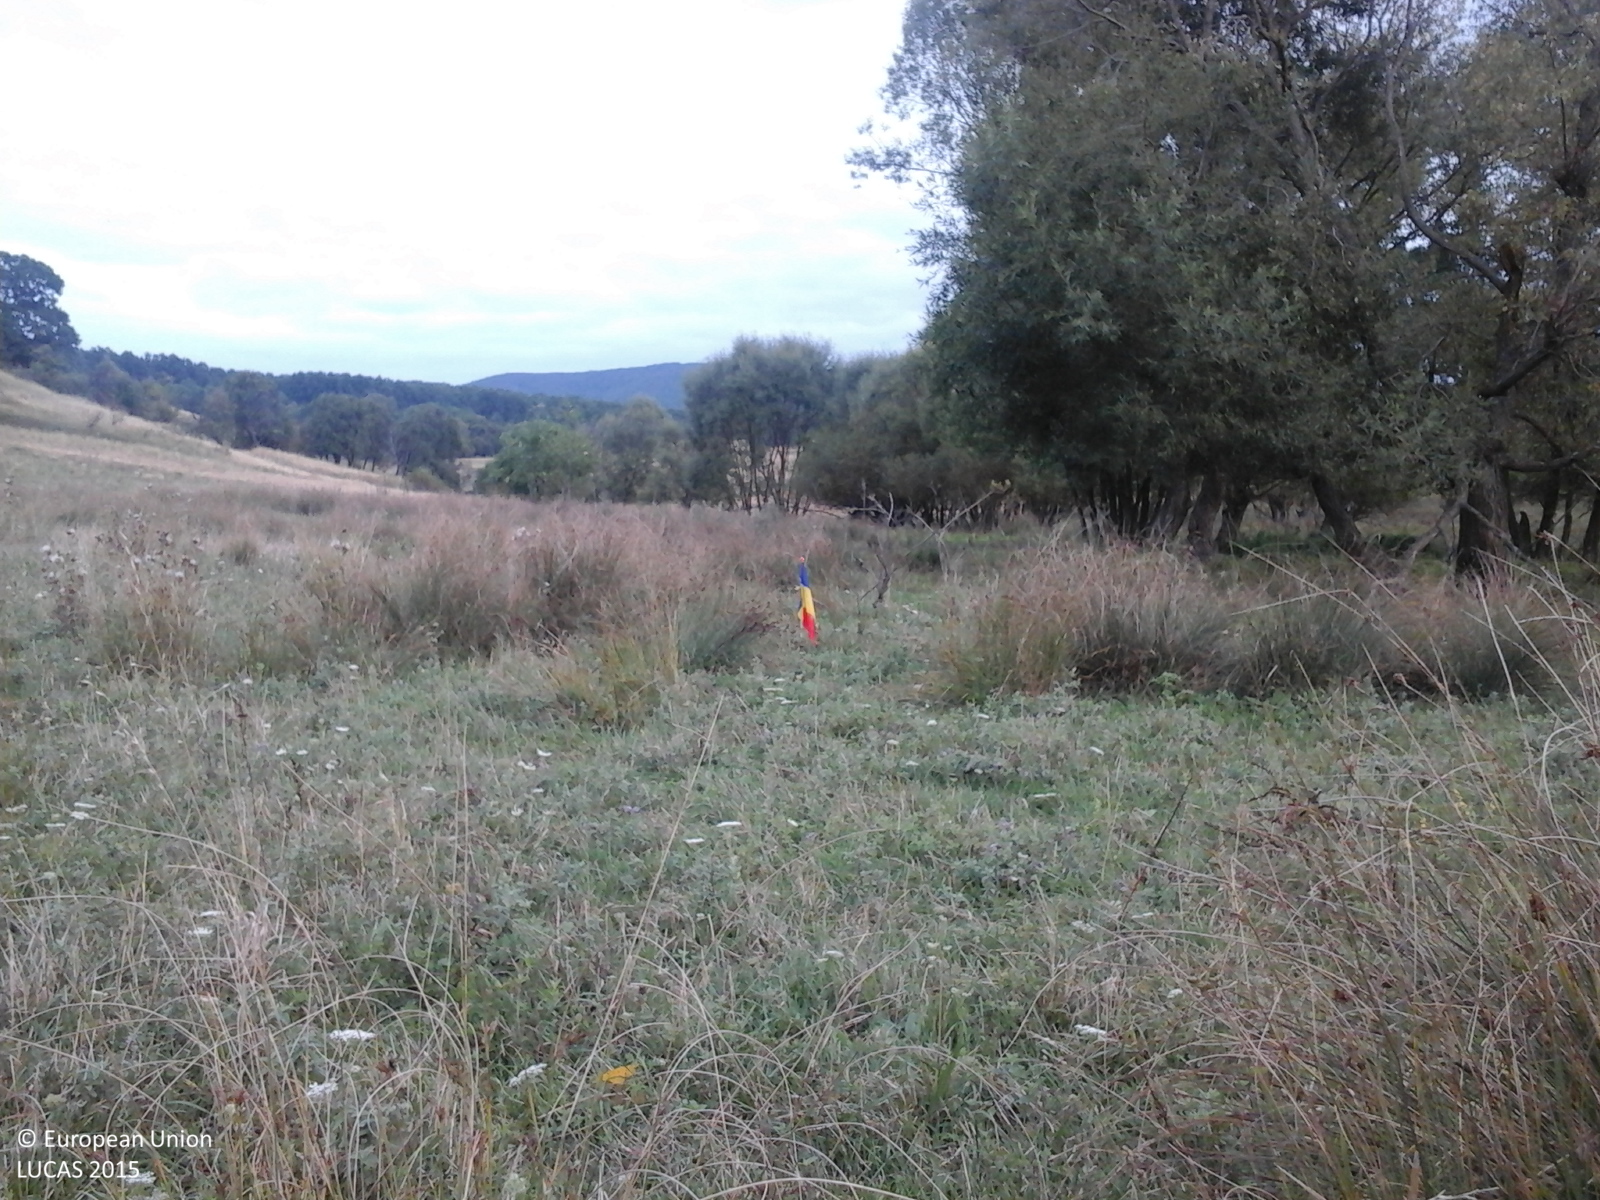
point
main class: Grassland
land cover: Grassland without tree/shrub cover
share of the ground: > 75 %
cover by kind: herbaceous plants 100 %
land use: Agriculture (excluding fallow land and kitchen gardens)
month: September
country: RO
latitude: 47.1402
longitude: 22.9981
